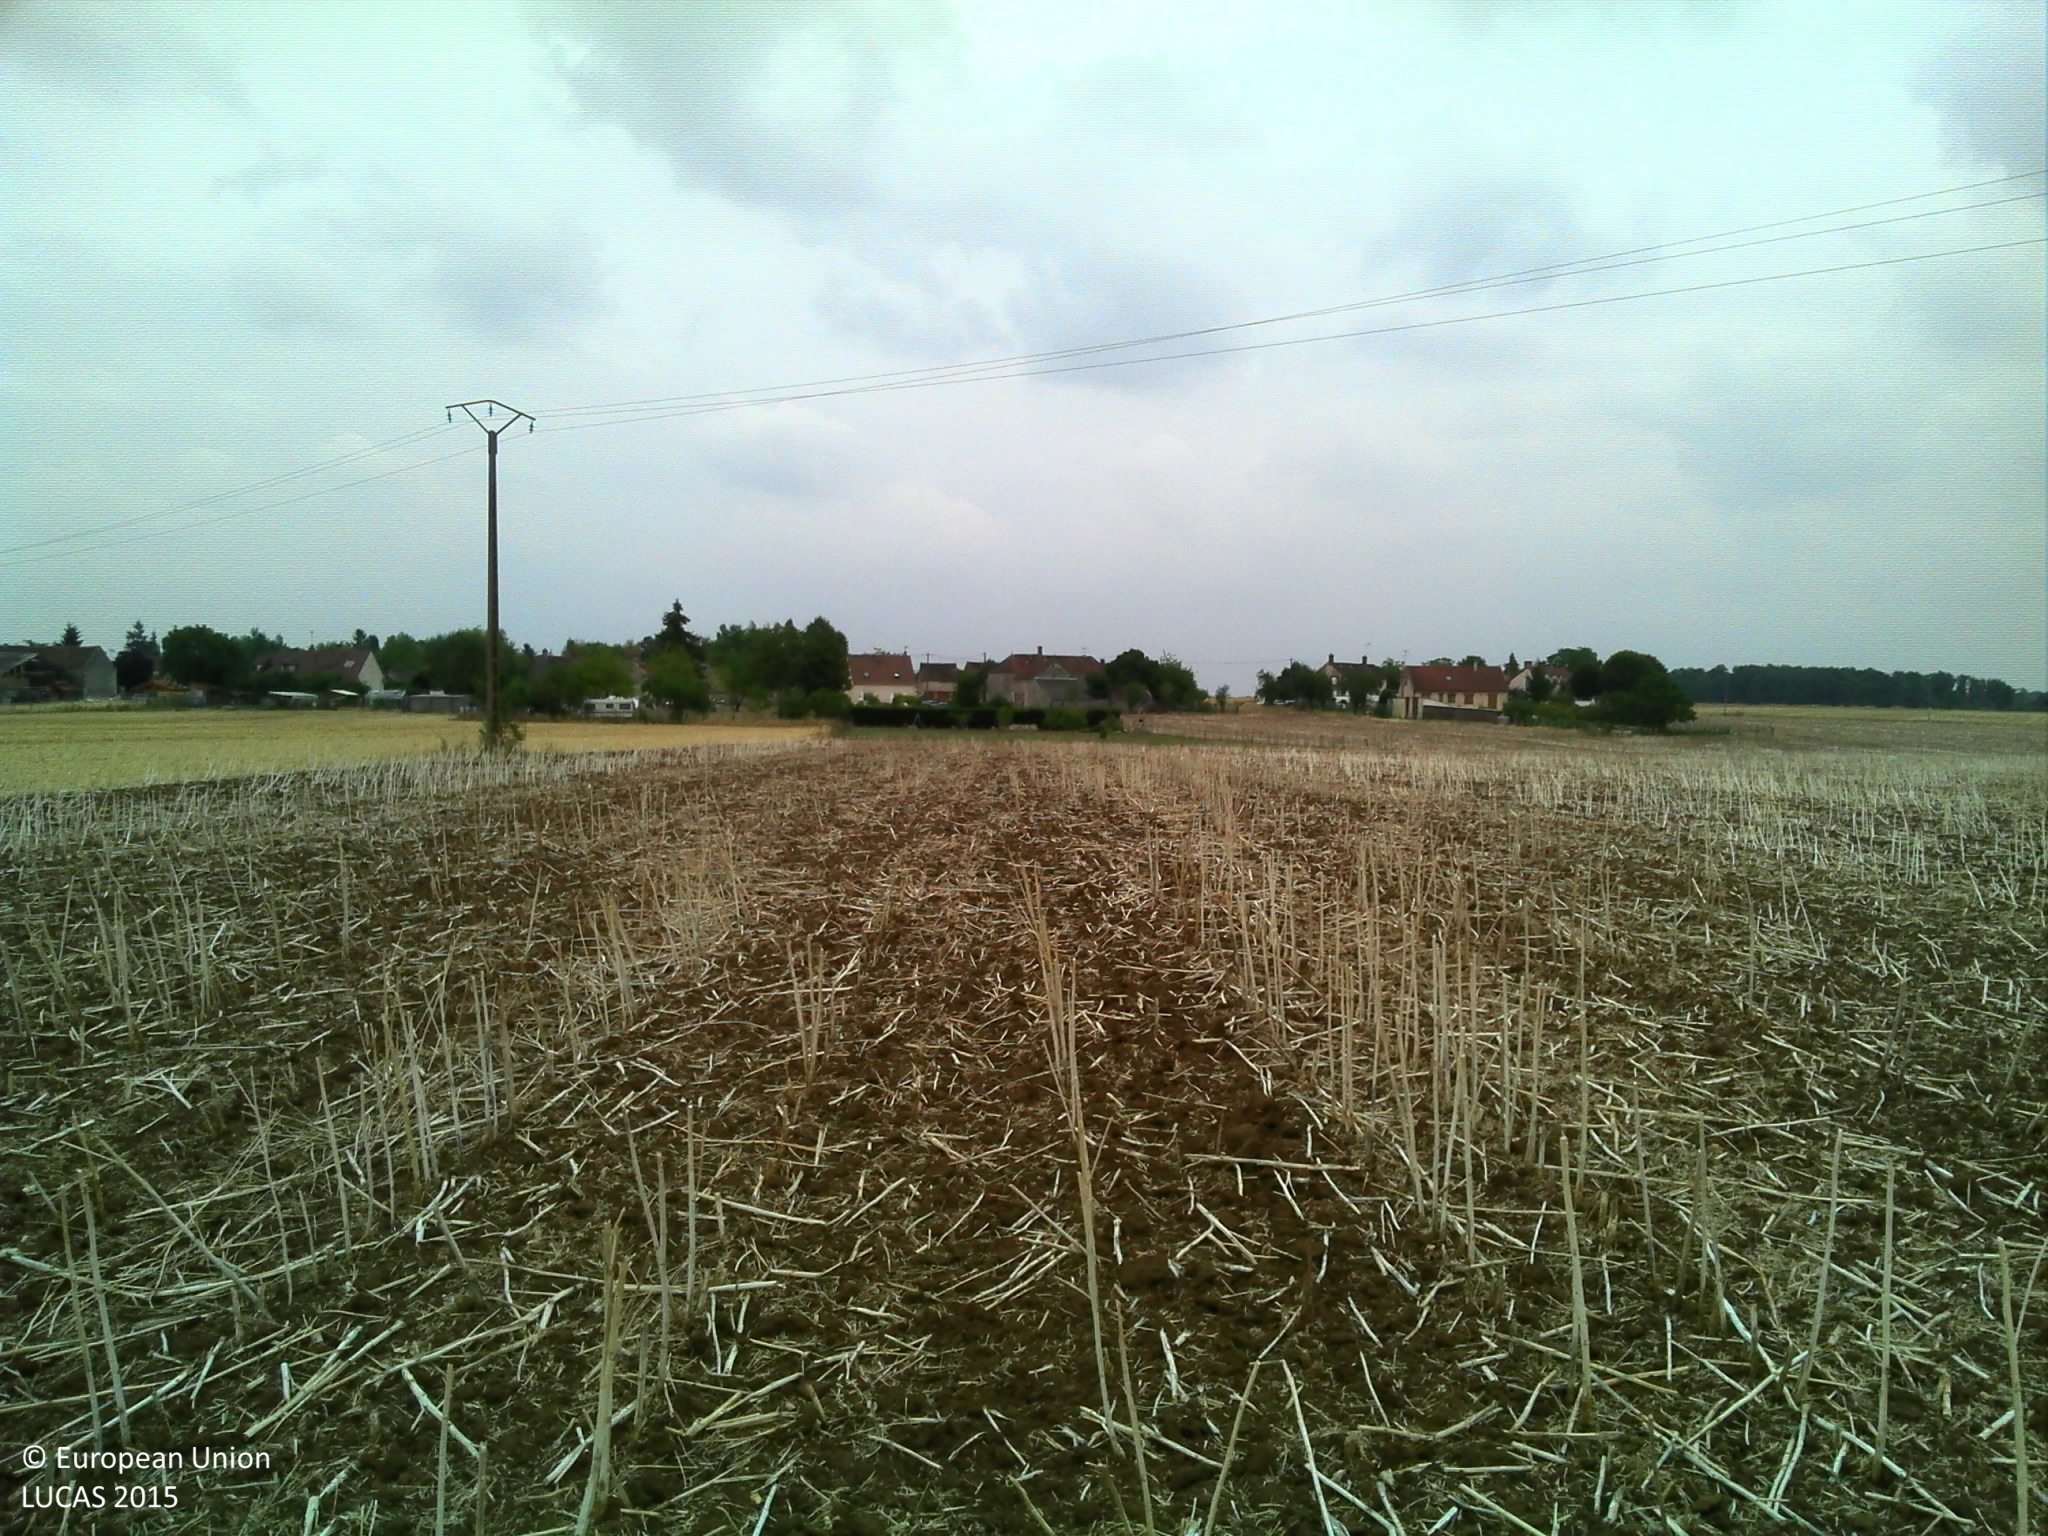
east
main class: Cropland
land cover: Rape and turnip rape
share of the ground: 10 - 25 %
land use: Agriculture (excluding fallow land and kitchen gardens)
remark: Harvested field
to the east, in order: Rape and turnip rape; Electric lines; Rape and turnip rape; Fences; Grassland with sparse tree/shrub cover; Fences; Rape and turnip rape
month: August
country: FR
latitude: 48.1846
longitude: 2.7685
